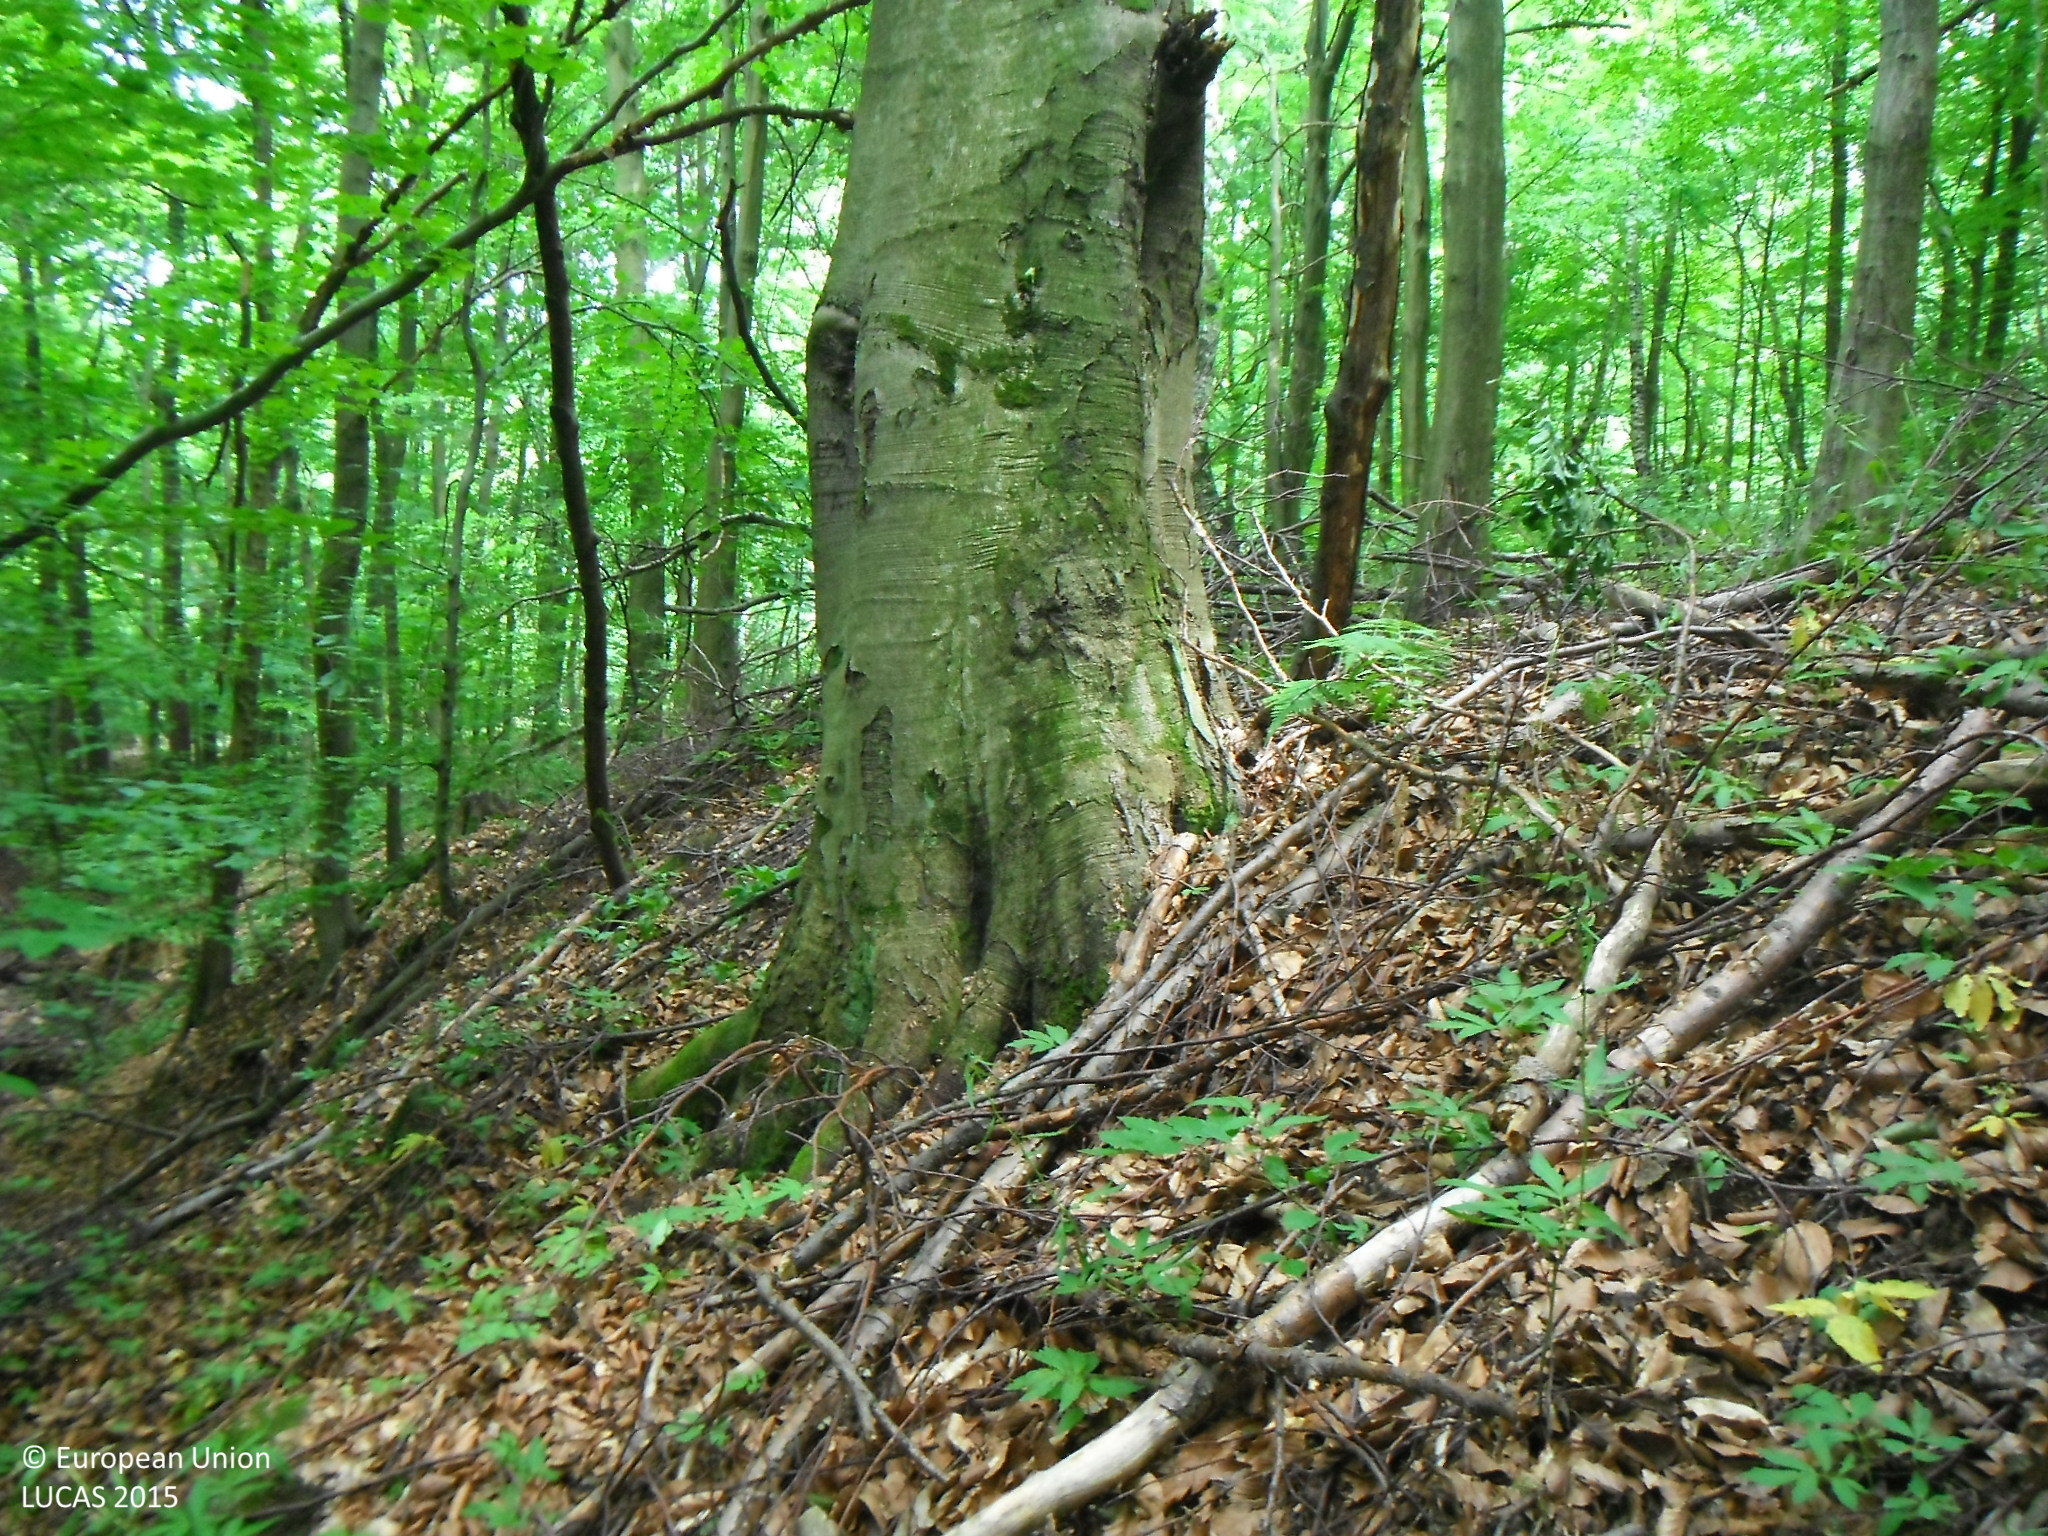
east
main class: Woodland
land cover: Broadleaved woodland
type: beech forest
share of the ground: > 75 %
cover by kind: broadleaved forest trees 100 %
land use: Forestry
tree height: > 5 m
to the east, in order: Broadleaved woodland
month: June
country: SK
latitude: 48.8691
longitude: 21.5414
